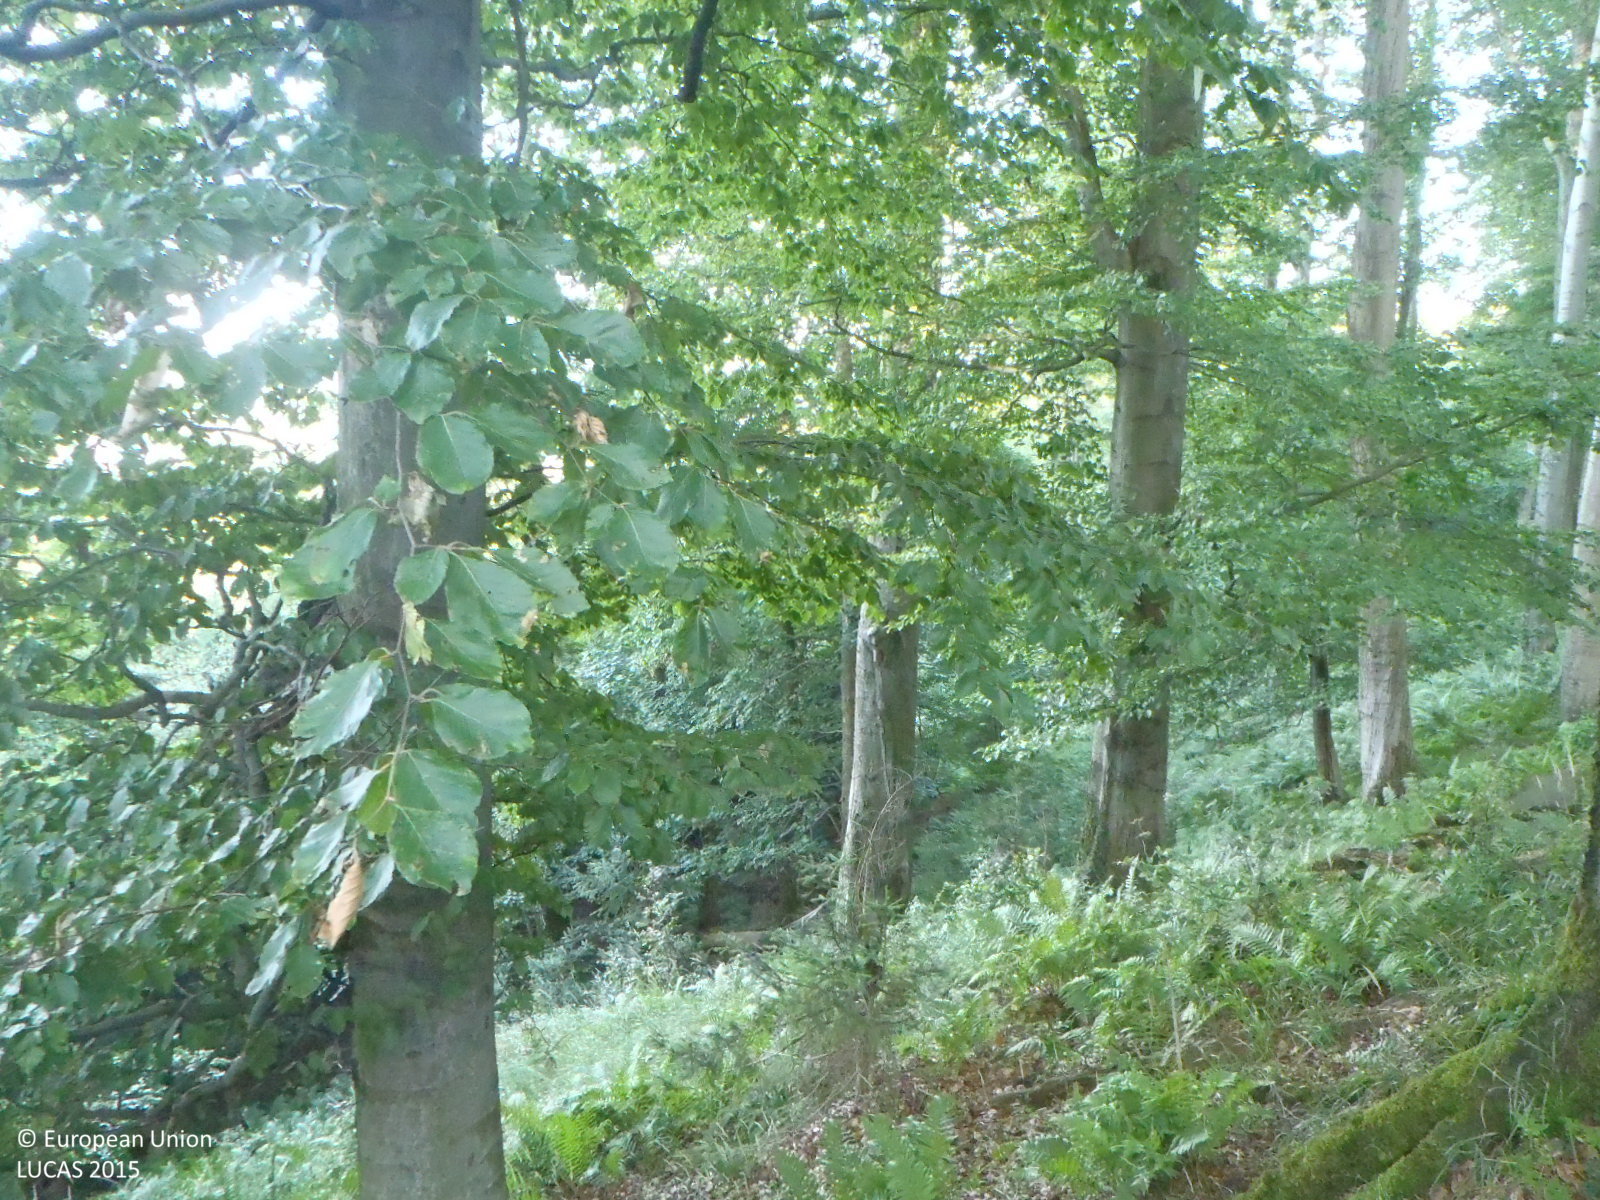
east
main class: Woodland
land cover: Broadleaved woodland
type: beech forest
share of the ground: > 75 %
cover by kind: broadleaved forest trees 95 %, herbaceous plants 5 %
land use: Forestry
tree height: > 5 m
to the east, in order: Broadleaved woodland; Spruce dominated mixed woodland; Spruce dominated coniferous woodland; Tracks; Spruce dominated coniferous woodland; Other coniferous woodland; Spruce dominated coniferous woodland
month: August
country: CZ
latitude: 50.7956
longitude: 14.5561
